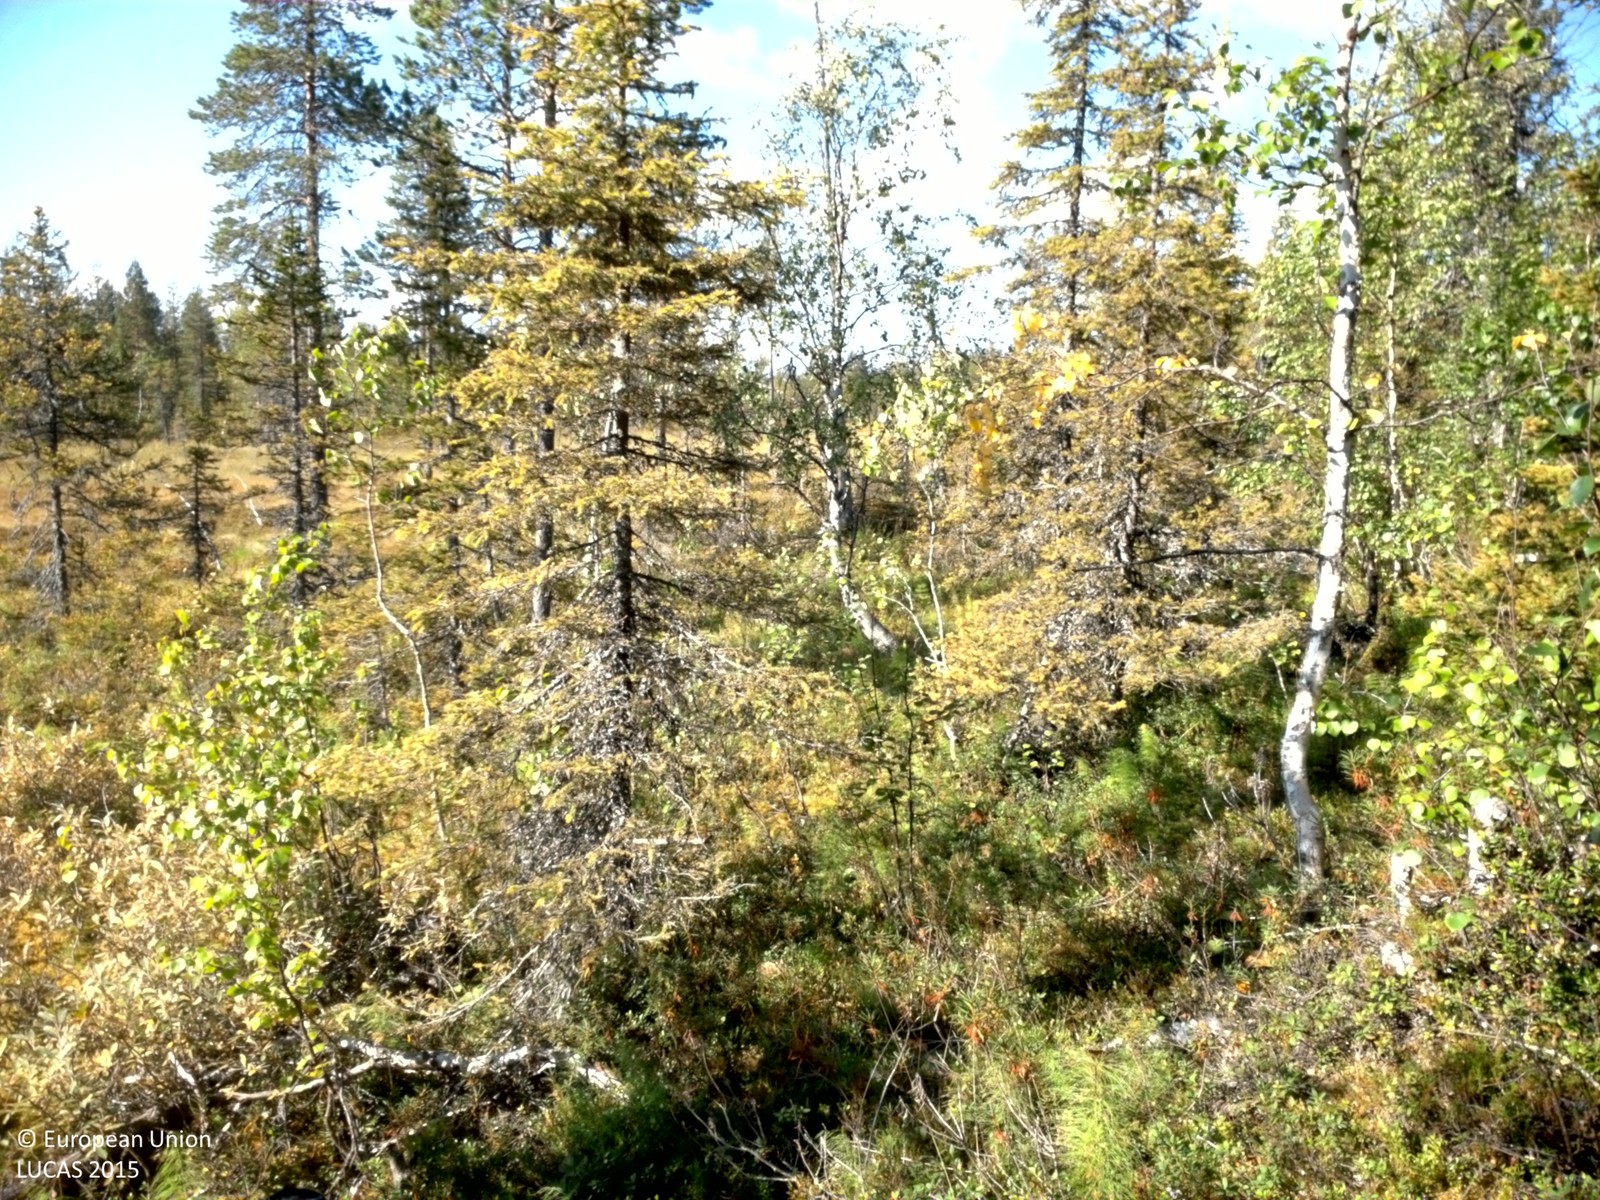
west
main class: Woodland
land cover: Spruce dominated mixed woodland
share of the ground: 25 - 50 %
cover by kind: shrubs 60 %, coniferous forest trees 20 %, broadleaved forest trees 10 %, lichens and mosses 10 %
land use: Forestry
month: August
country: SE
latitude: 66.6949
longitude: 20.8510
